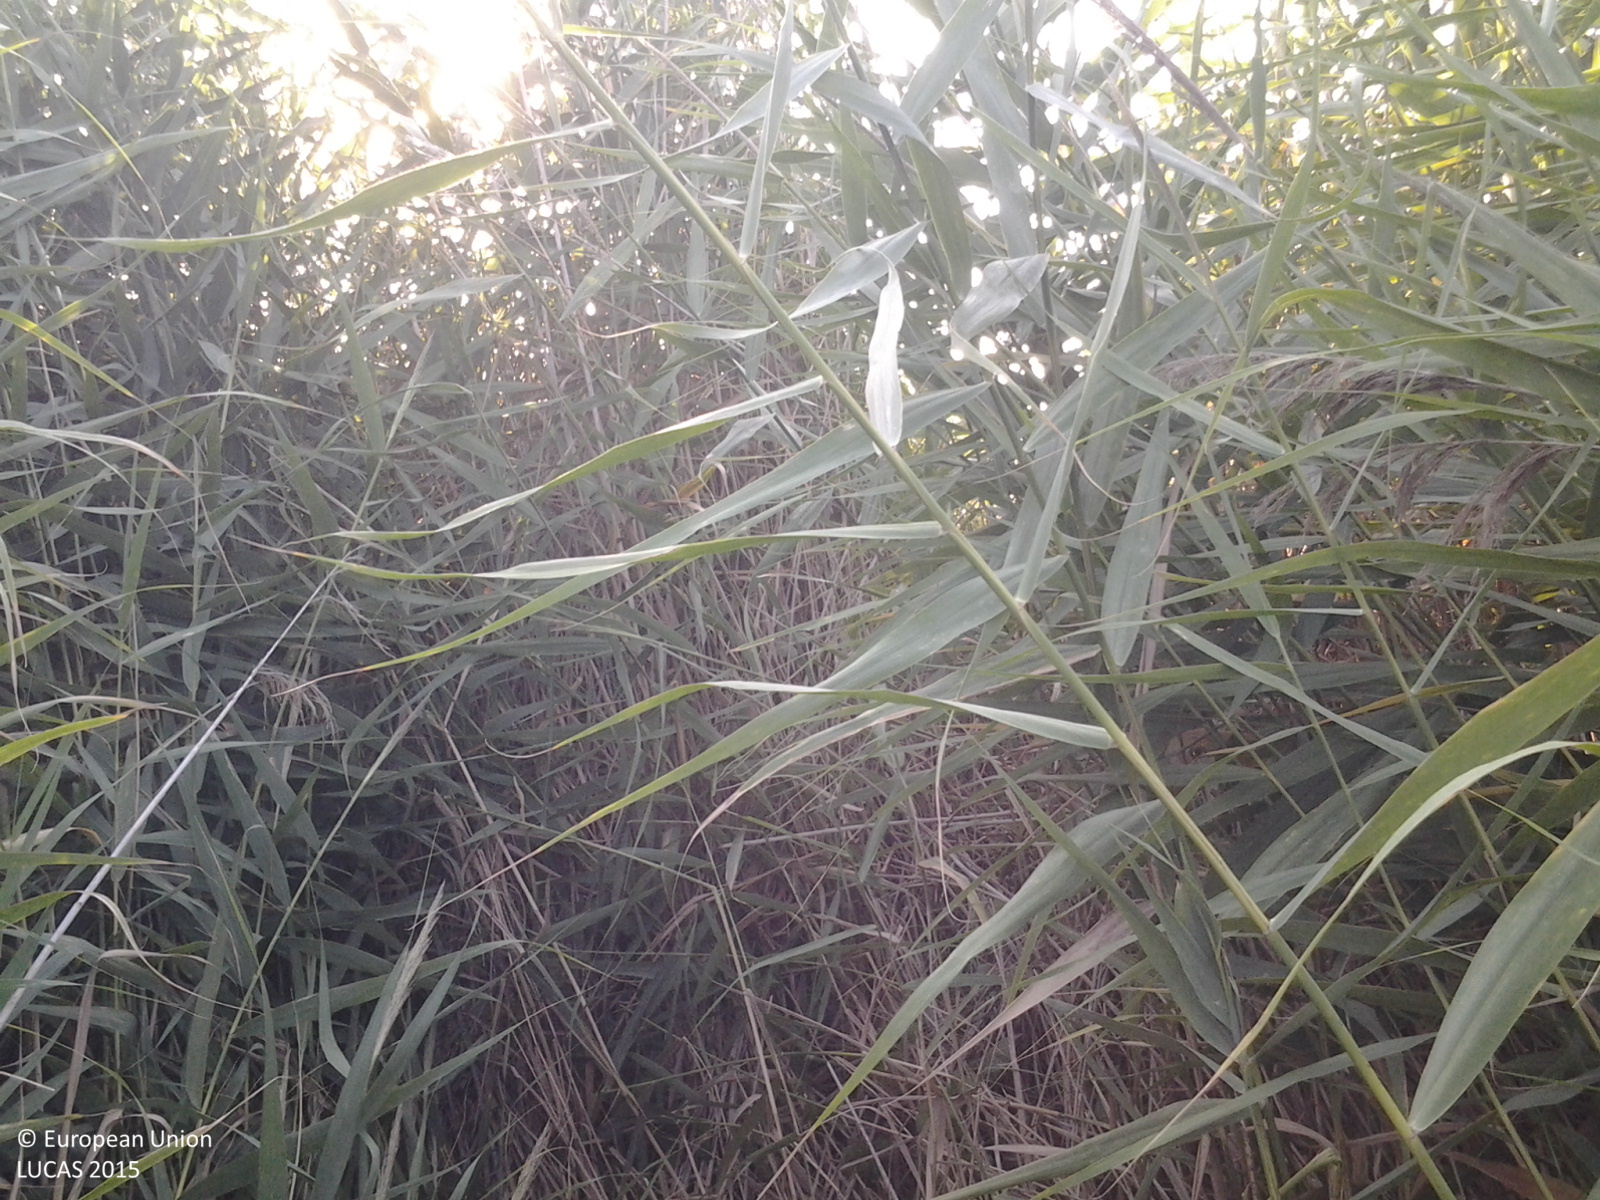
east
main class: Grassland
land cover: Spontaneously vegetated surfaces
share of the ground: > 75 %
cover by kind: herbaceous plants 100 %
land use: Semi-natural and natural areas not in use
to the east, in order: Spontaneously vegetated surfaces; Common wheat; Grass margins; Tracks
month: August
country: HU
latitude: 46.8815
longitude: 21.6017
